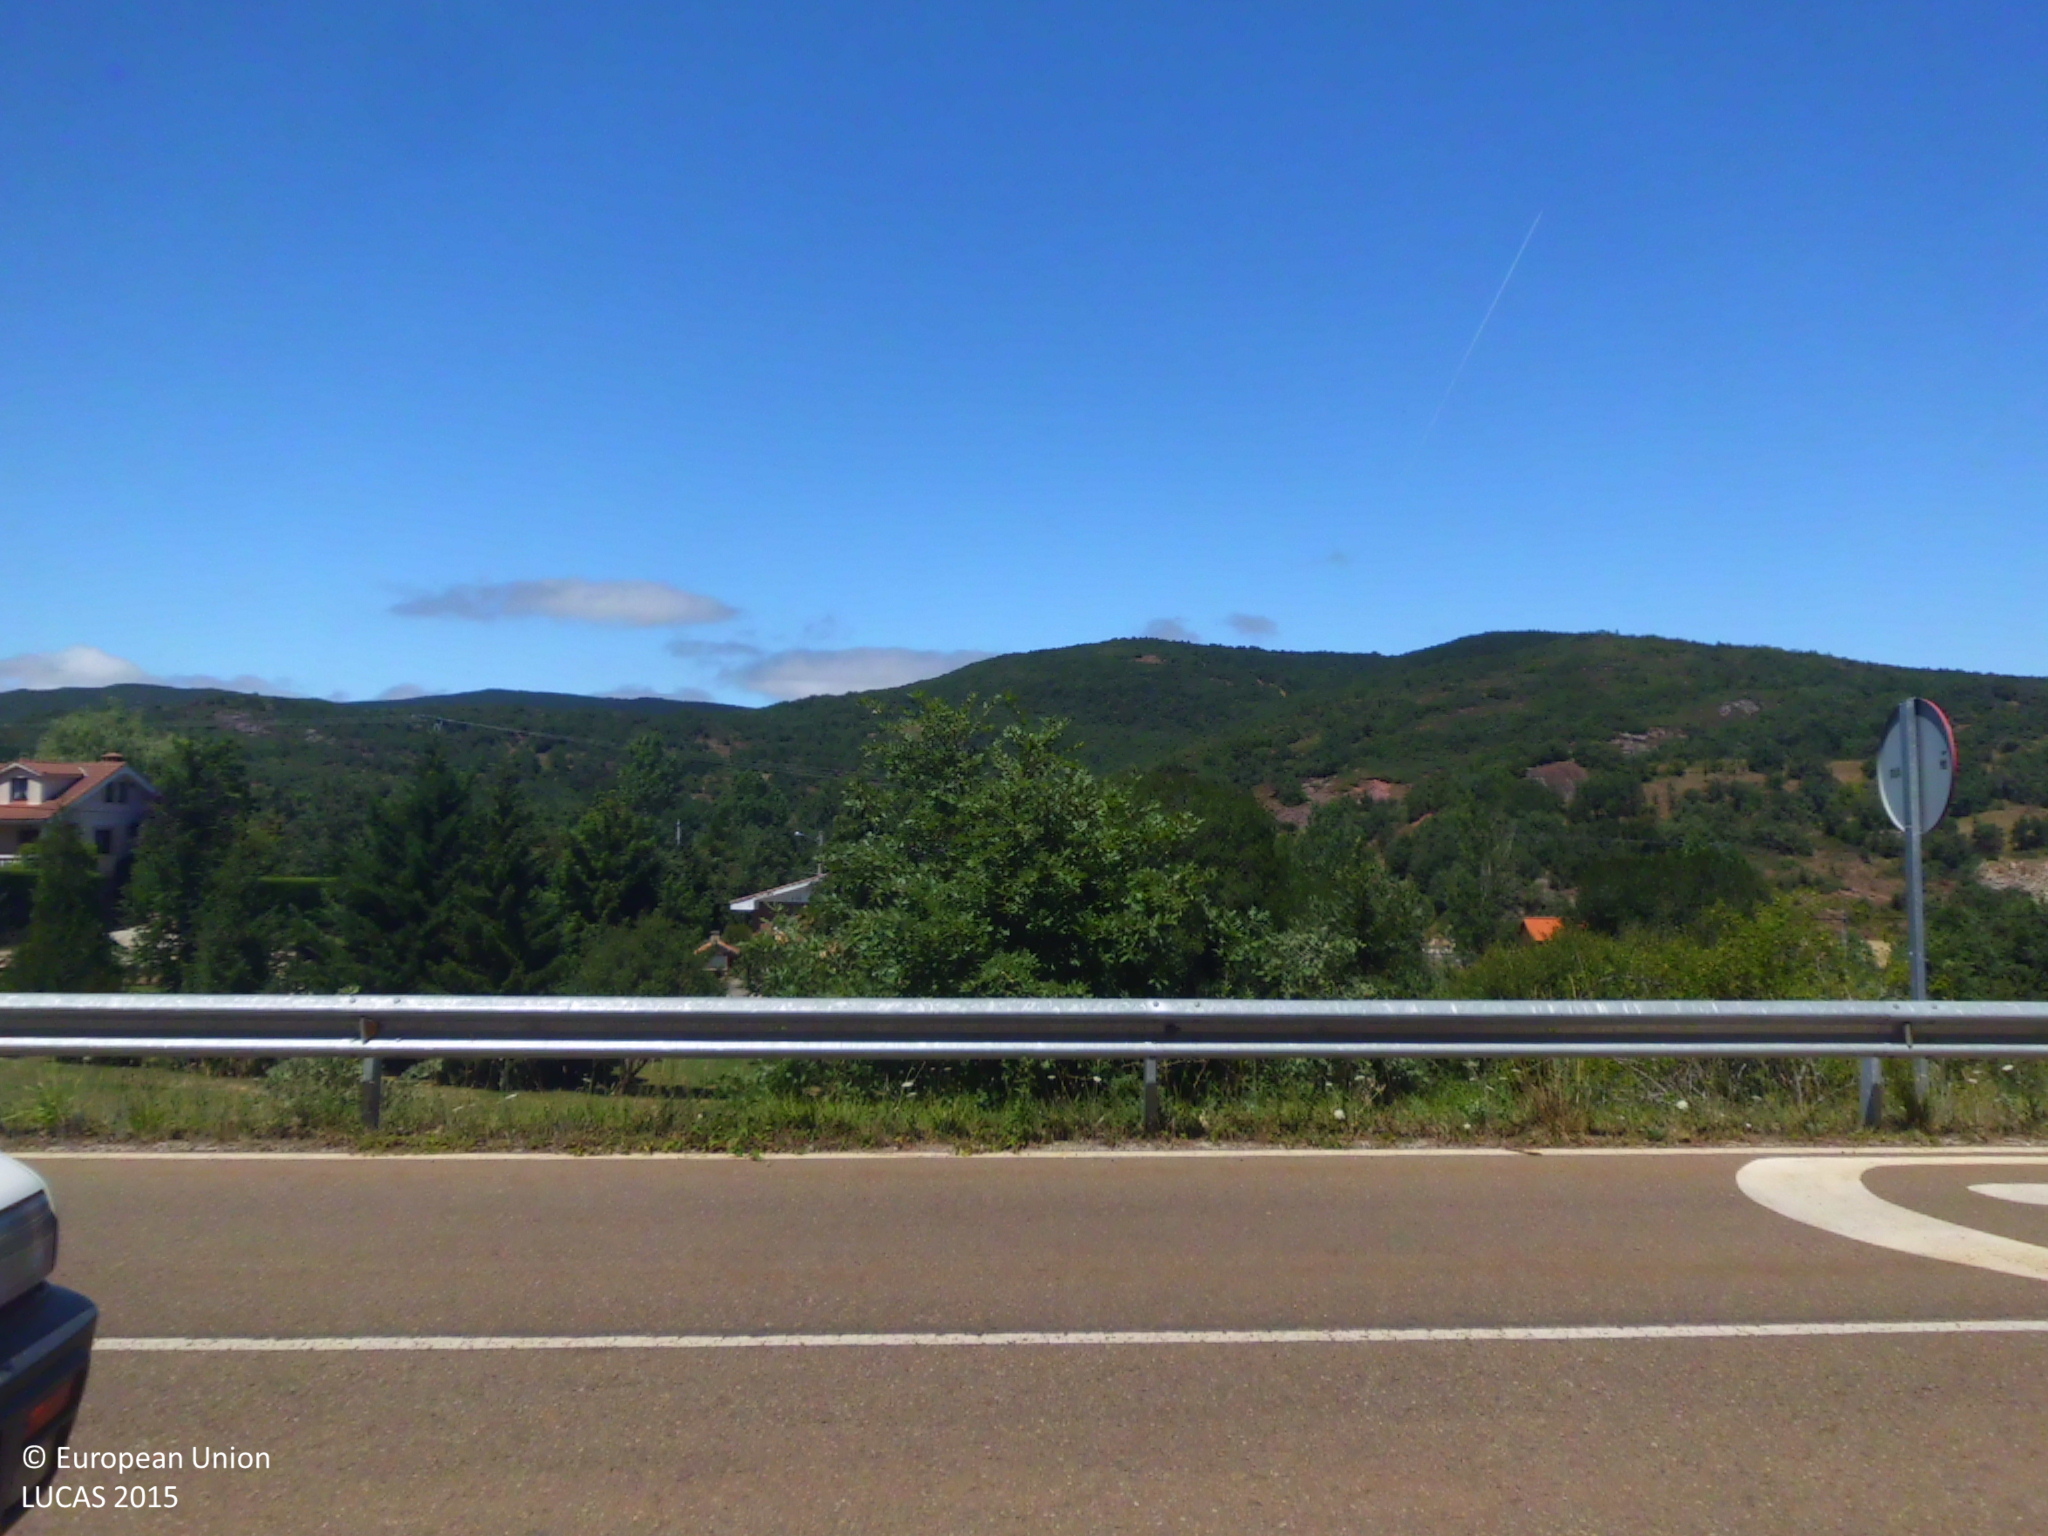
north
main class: Woodland
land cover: Broadleaved woodland
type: mesophytic deciduous forest
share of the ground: 50 - 75 %
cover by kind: broadleaved forest trees 50 %, herbaceous plants 20 %, consolidated bare surface 20 %, shrubs 10 %
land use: Semi-natural and natural areas not in use
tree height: > 5 m
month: July
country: ES
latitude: 42.7974
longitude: -4.0957
